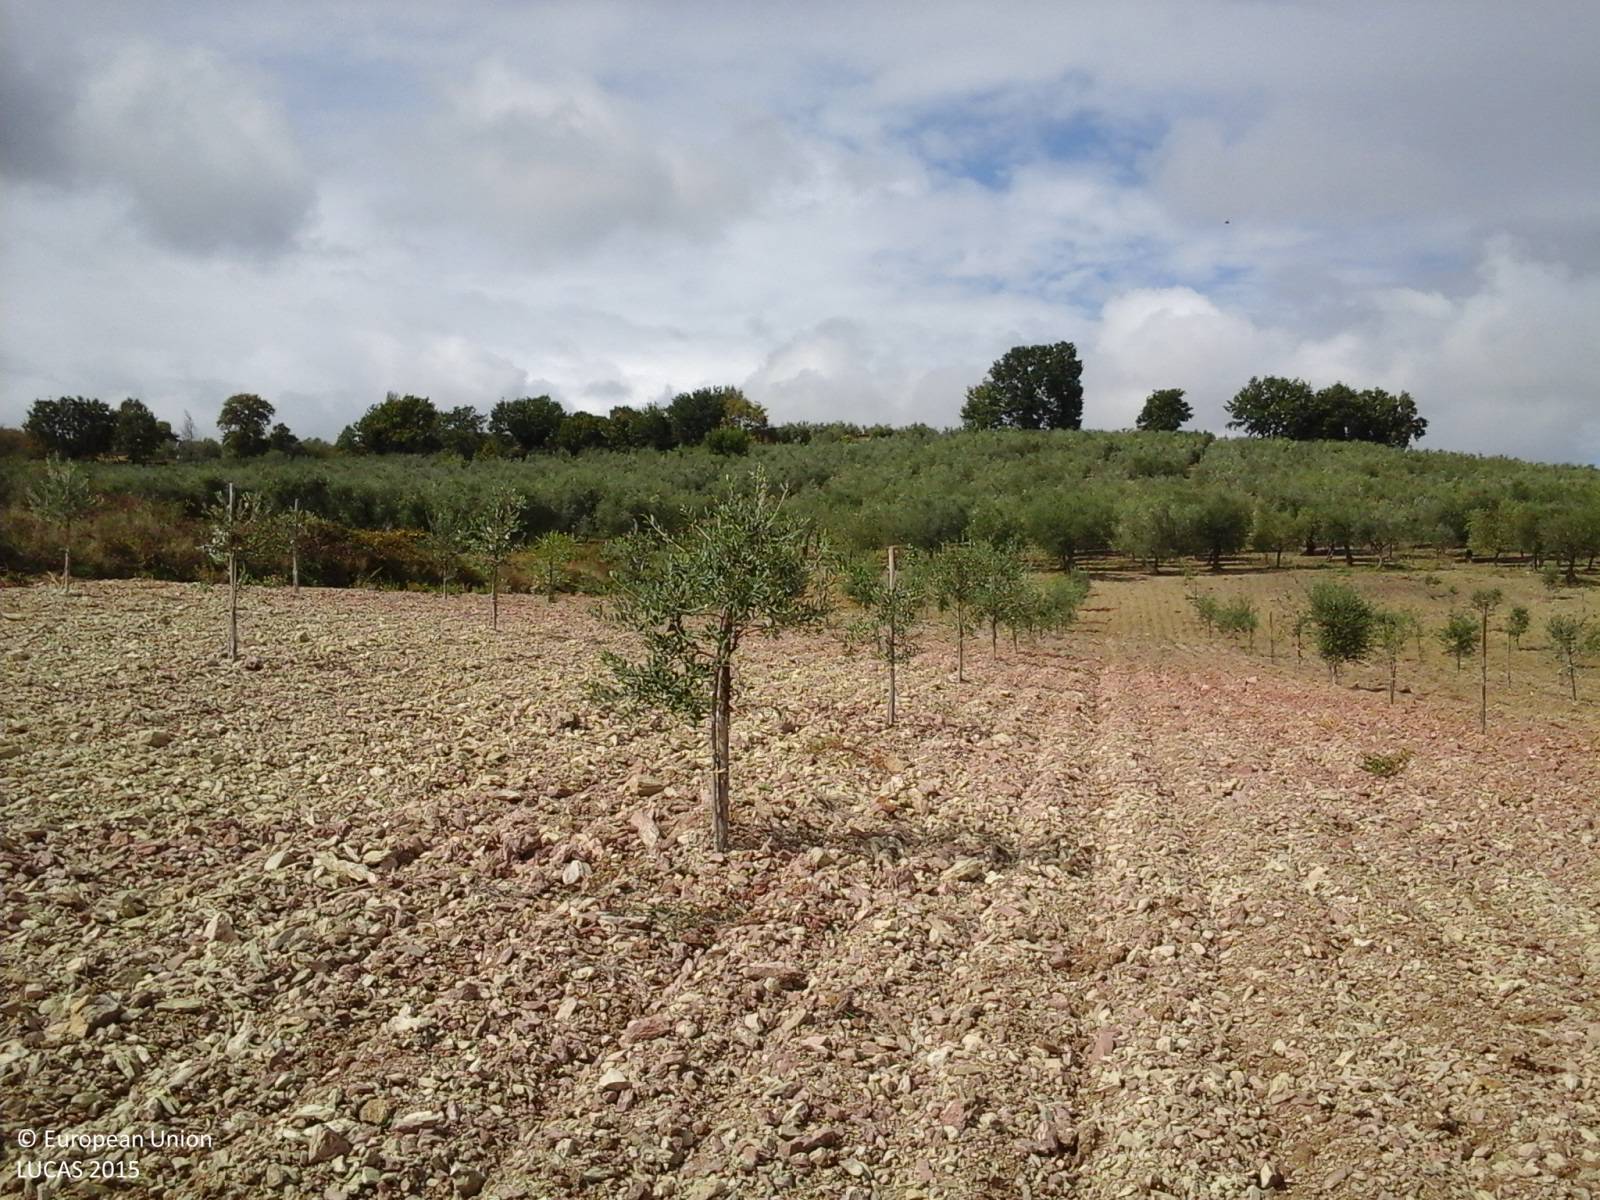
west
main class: Cropland
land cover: Olive groves
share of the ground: 10 - 25 %
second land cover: Other bare soil
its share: > 75 %
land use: Agriculture (excluding fallow land and kitchen gardens)
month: September
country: IT
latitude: 42.8375
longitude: 12.5981
